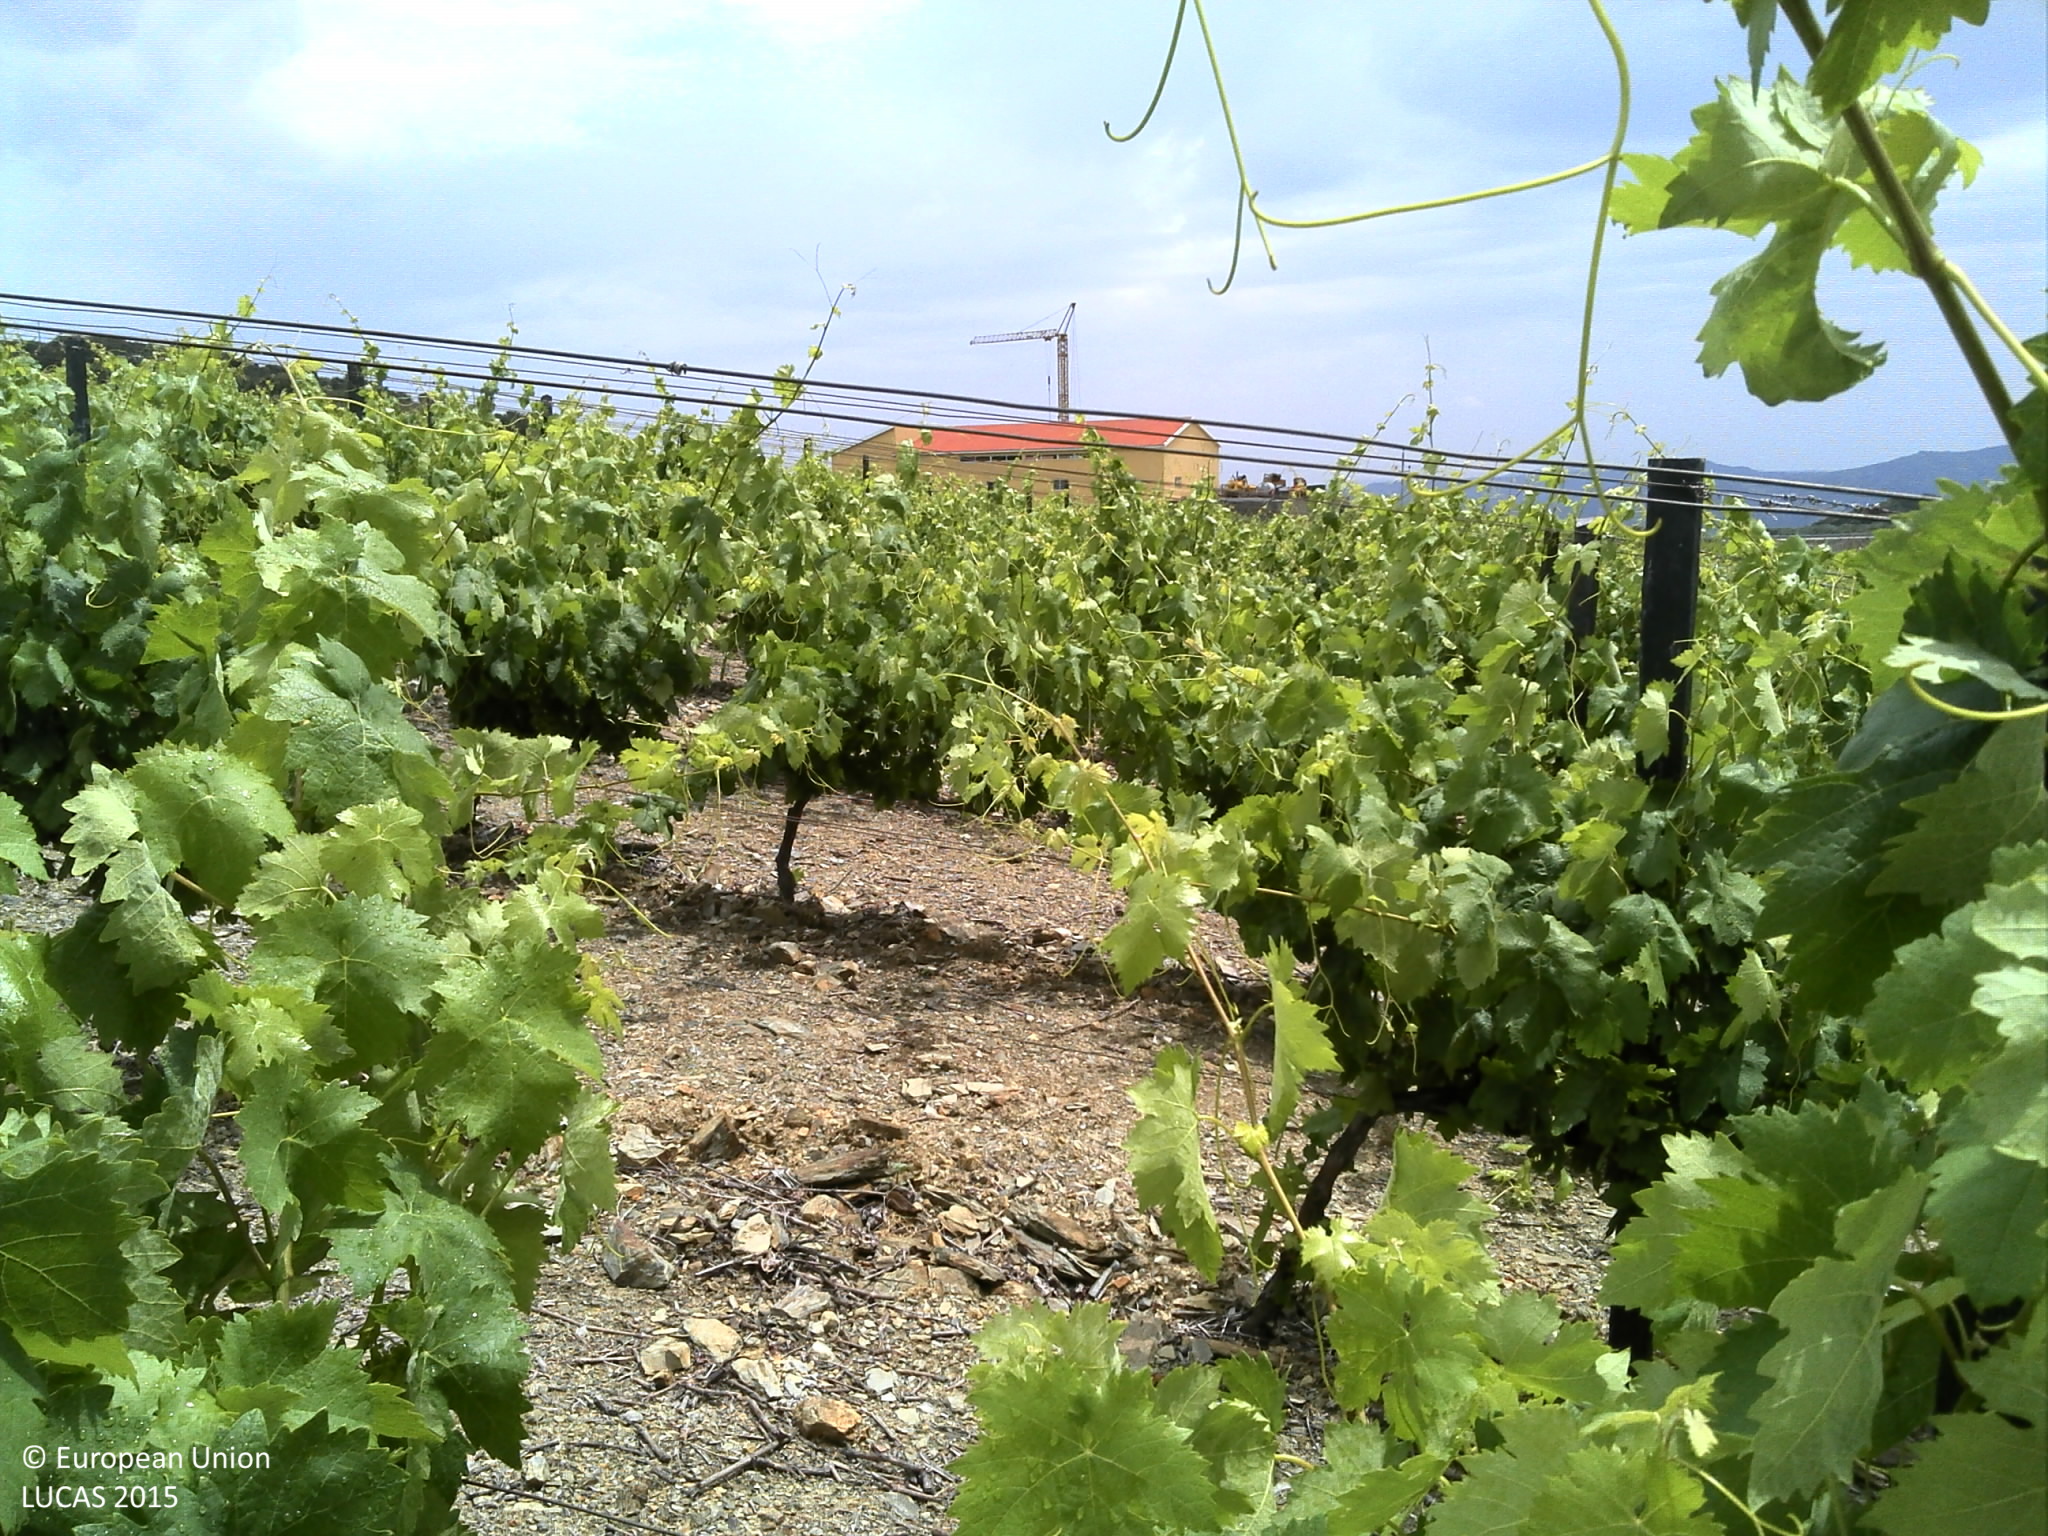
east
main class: Cropland
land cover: Vineyards
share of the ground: < 10 %
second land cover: Other bare soil
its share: > 75 %
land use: Agriculture (excluding fallow land and kitchen gardens)
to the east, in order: Vineyards; Other bare soil; Tracks; Vineyards; Tracks; Vineyards; Electric lines; Vineyards; Tracks; Grass margins; Tracks; Vineyards; Spontaneously vegetated surfaces; Artificial constructions in urban areas
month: June
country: PT
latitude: 41.1335
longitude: -7.4041
